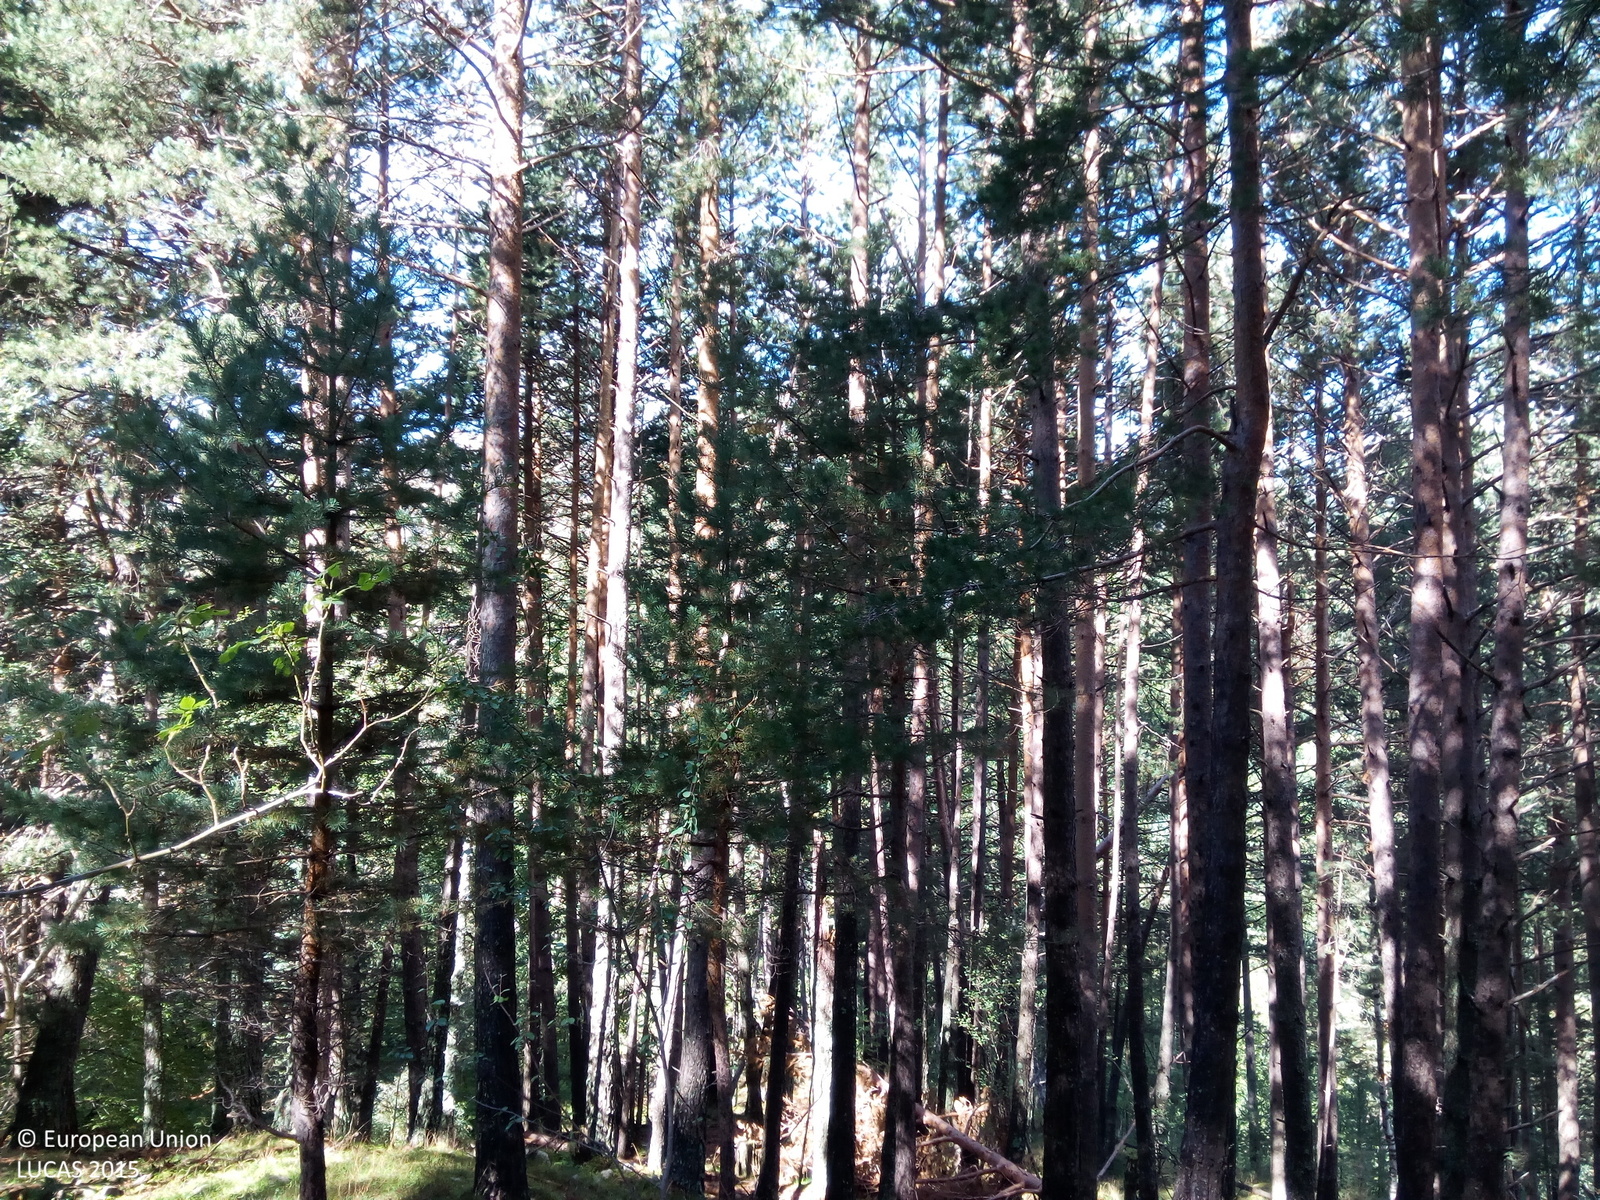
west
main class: Woodland
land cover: Pine dominated coniferous woodland
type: alpine coniferous forest
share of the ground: > 75 %
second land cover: Grassland without tree/shrub cover
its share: 10 - 25 %
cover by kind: coniferous forest trees 75 %, shrubs 15 %, herbaceous plants 10 %
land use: Forestry
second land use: Agriculture (excluding fallow land and kitchen gardens)
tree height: > 5 m
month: September
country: ES
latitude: 42.6471
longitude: 0.3549
